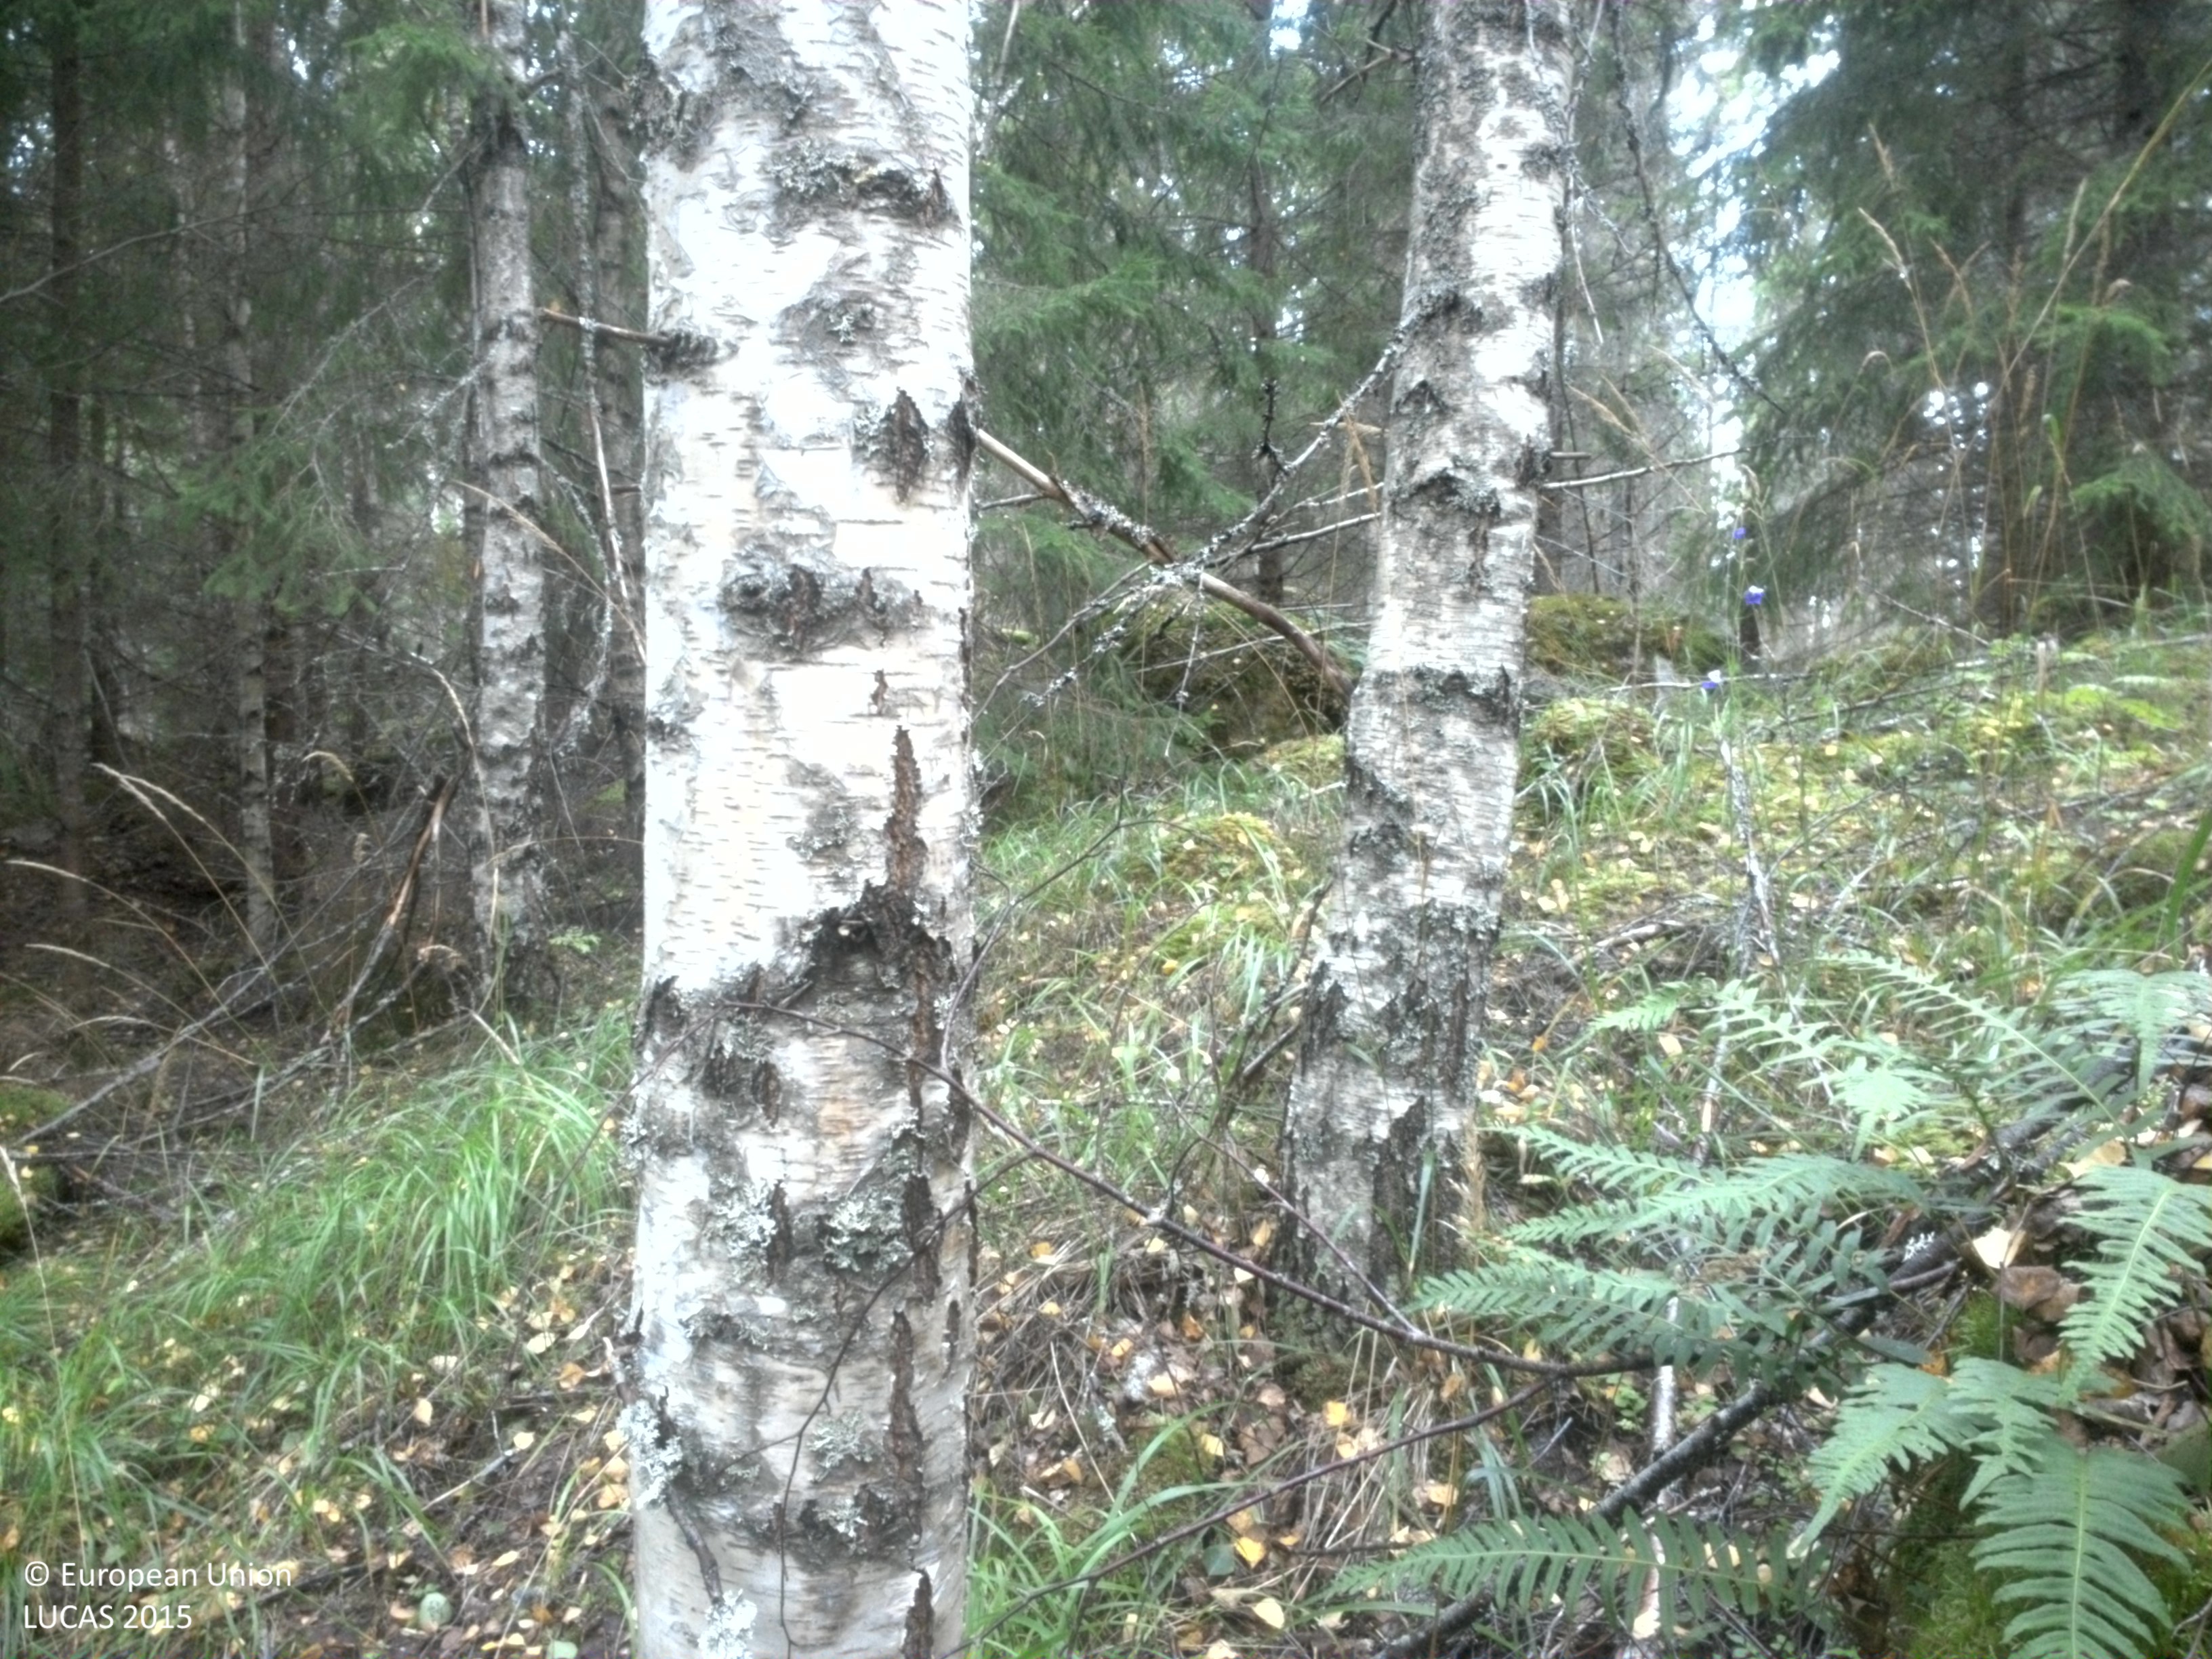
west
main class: Woodland
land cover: Spruce dominated mixed woodland
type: boreal forest
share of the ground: 50 - 75 %
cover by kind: coniferous forest trees 40 %, broadleaved forest trees 30 %, lichens and mosses 15 %, herbaceous plants 10 %, shrubs 5 %
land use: Forestry
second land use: Amenities, museums, leisure
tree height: > 5 m
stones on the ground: 25 - 50 %
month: September
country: SE
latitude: 59.5806
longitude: 15.6393
